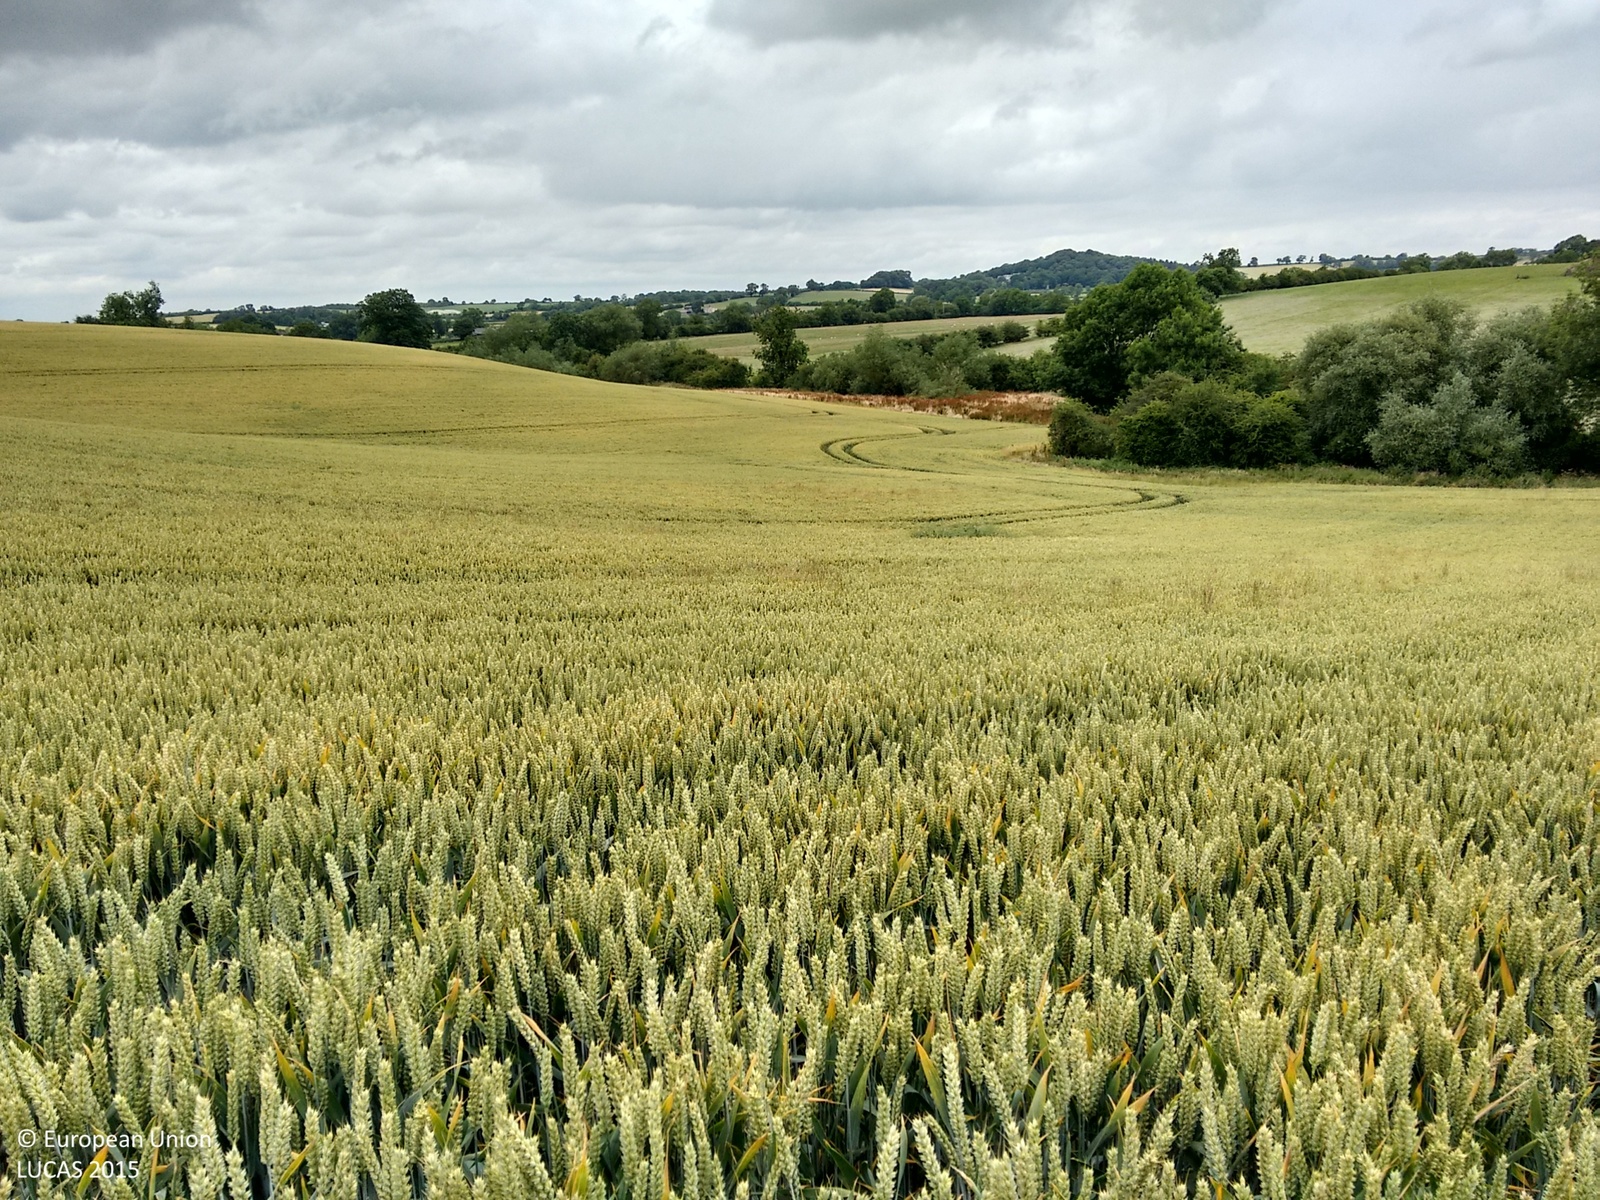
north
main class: Cropland
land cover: Common wheat
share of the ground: > 75 %
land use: Agriculture (excluding fallow land and kitchen gardens)
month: July
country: GB
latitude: 52.6126
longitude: -0.9576
